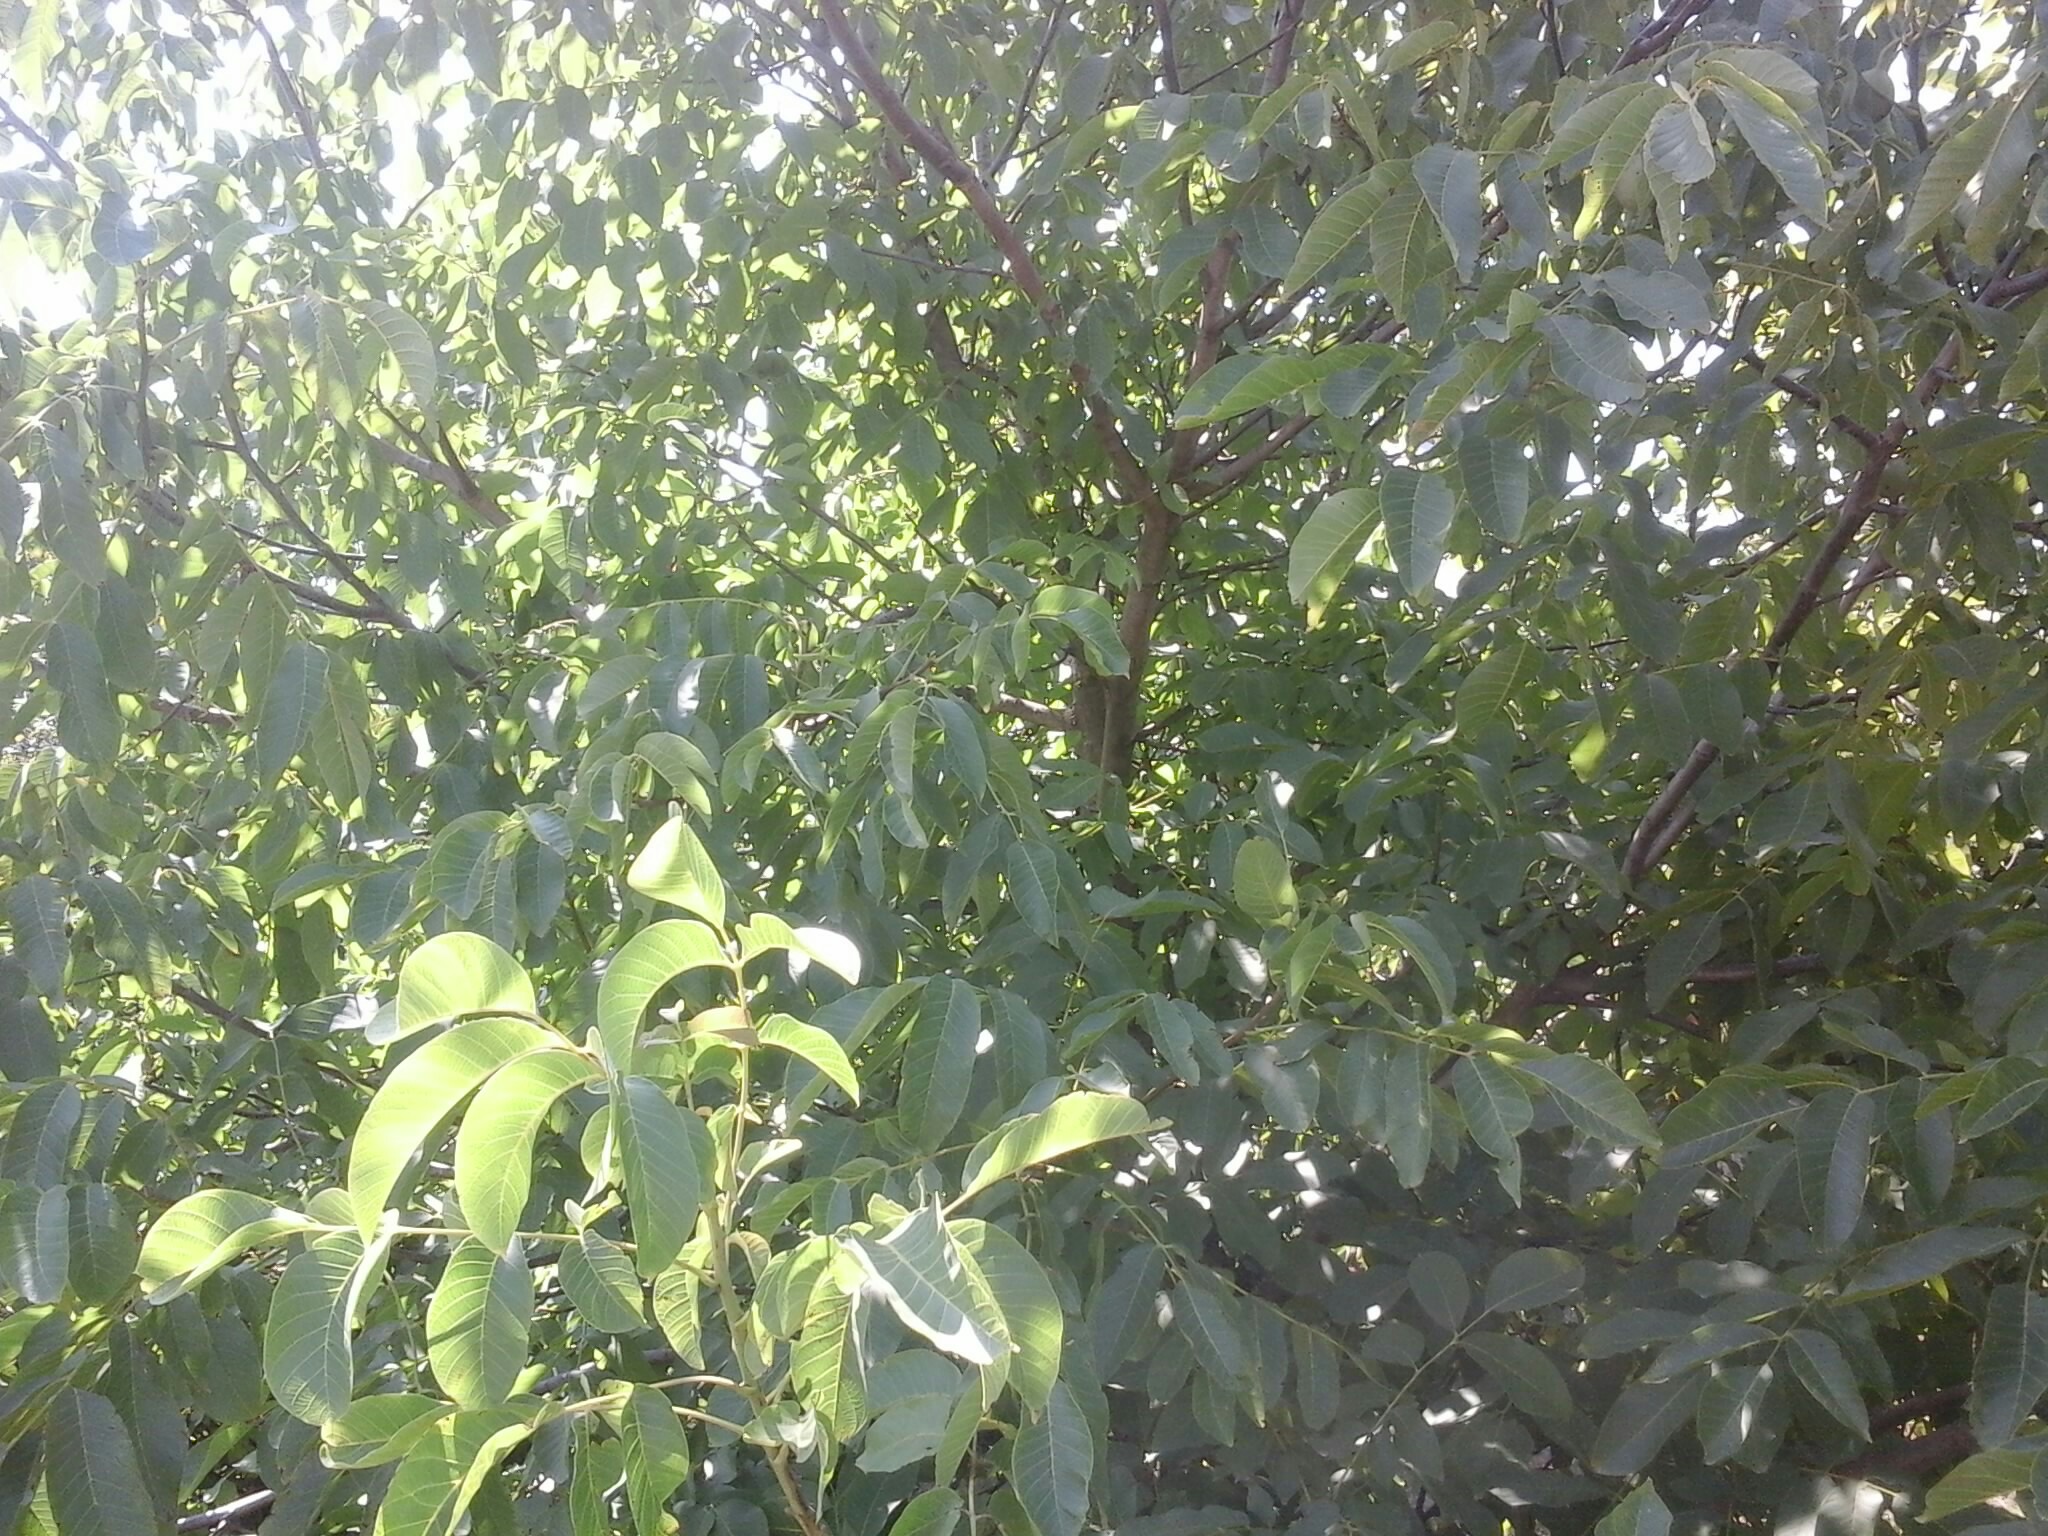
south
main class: Grassland
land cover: Grassland without tree/shrub cover
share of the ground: > 75 %
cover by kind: herbaceous plants 100 %
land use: Residential
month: August
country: HU
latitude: 47.4616
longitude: 18.0098
